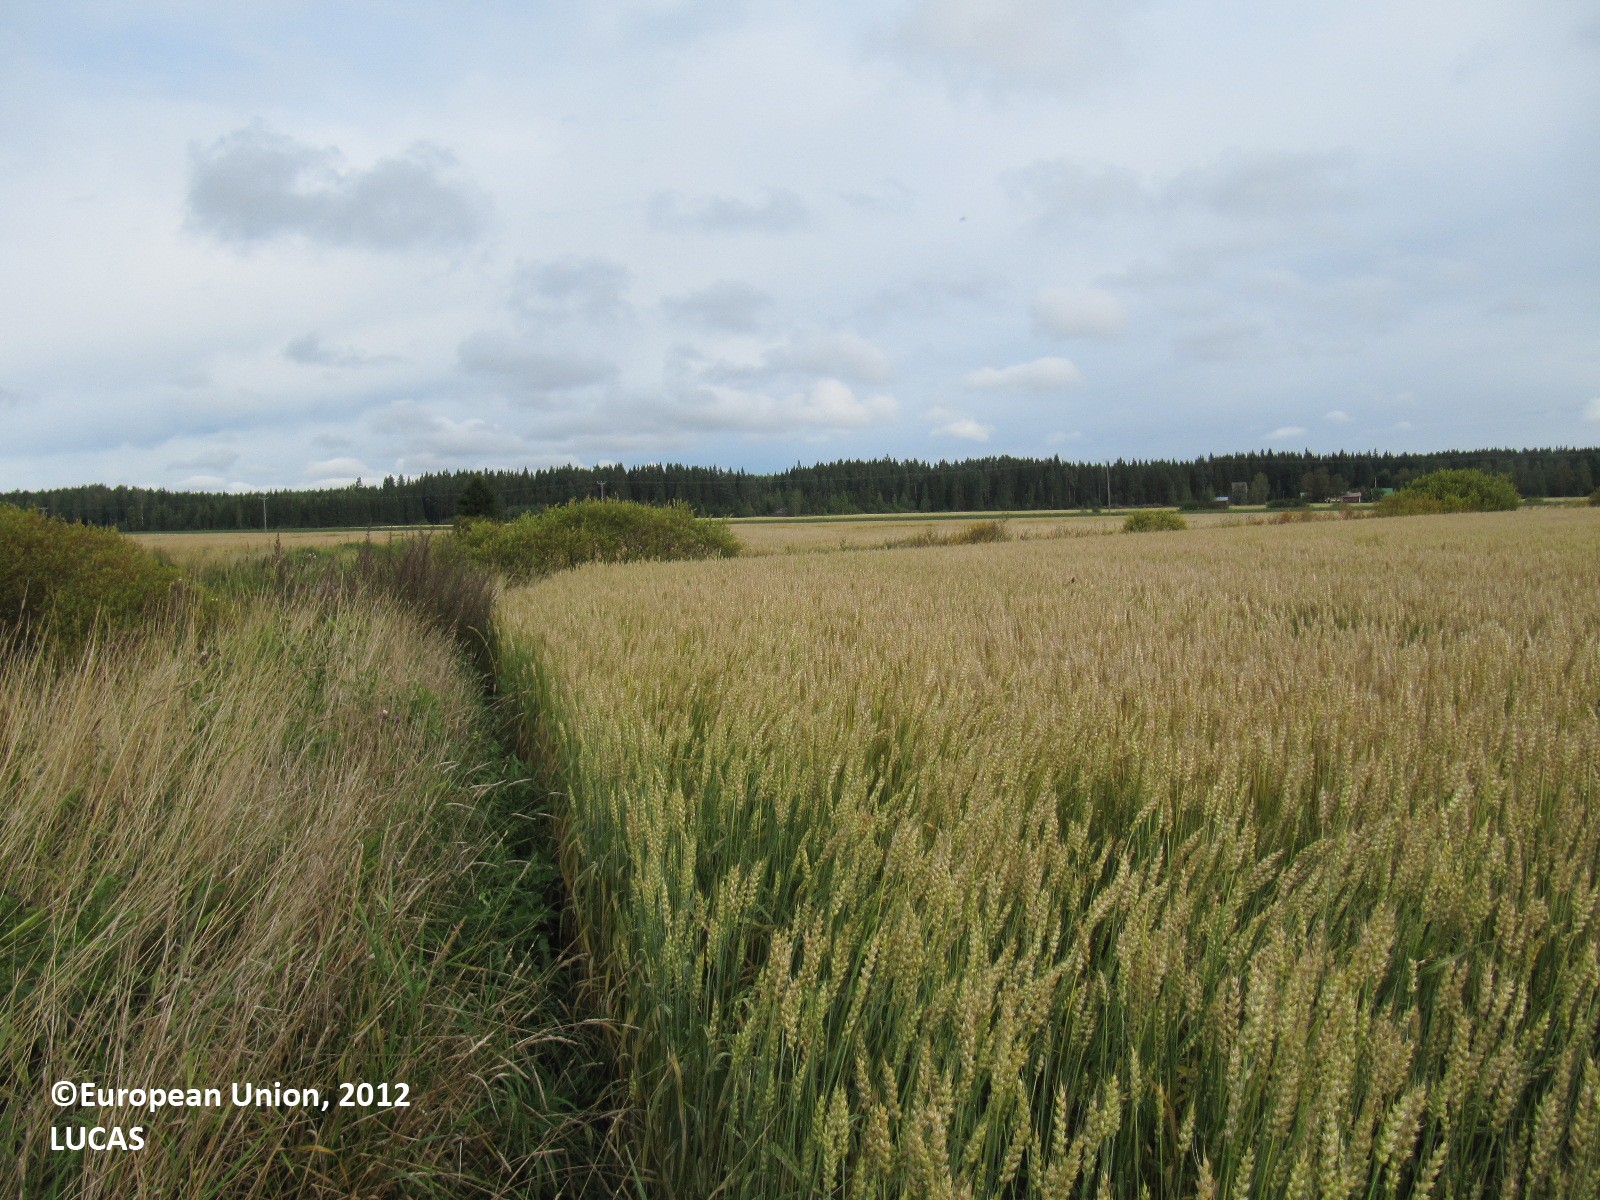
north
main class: Cropland
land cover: Common wheat
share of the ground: > 75 %
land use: Agriculture (excluding fallow land and kitchen gardens)
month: August
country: FI
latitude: 61.1308
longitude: 23.3930
